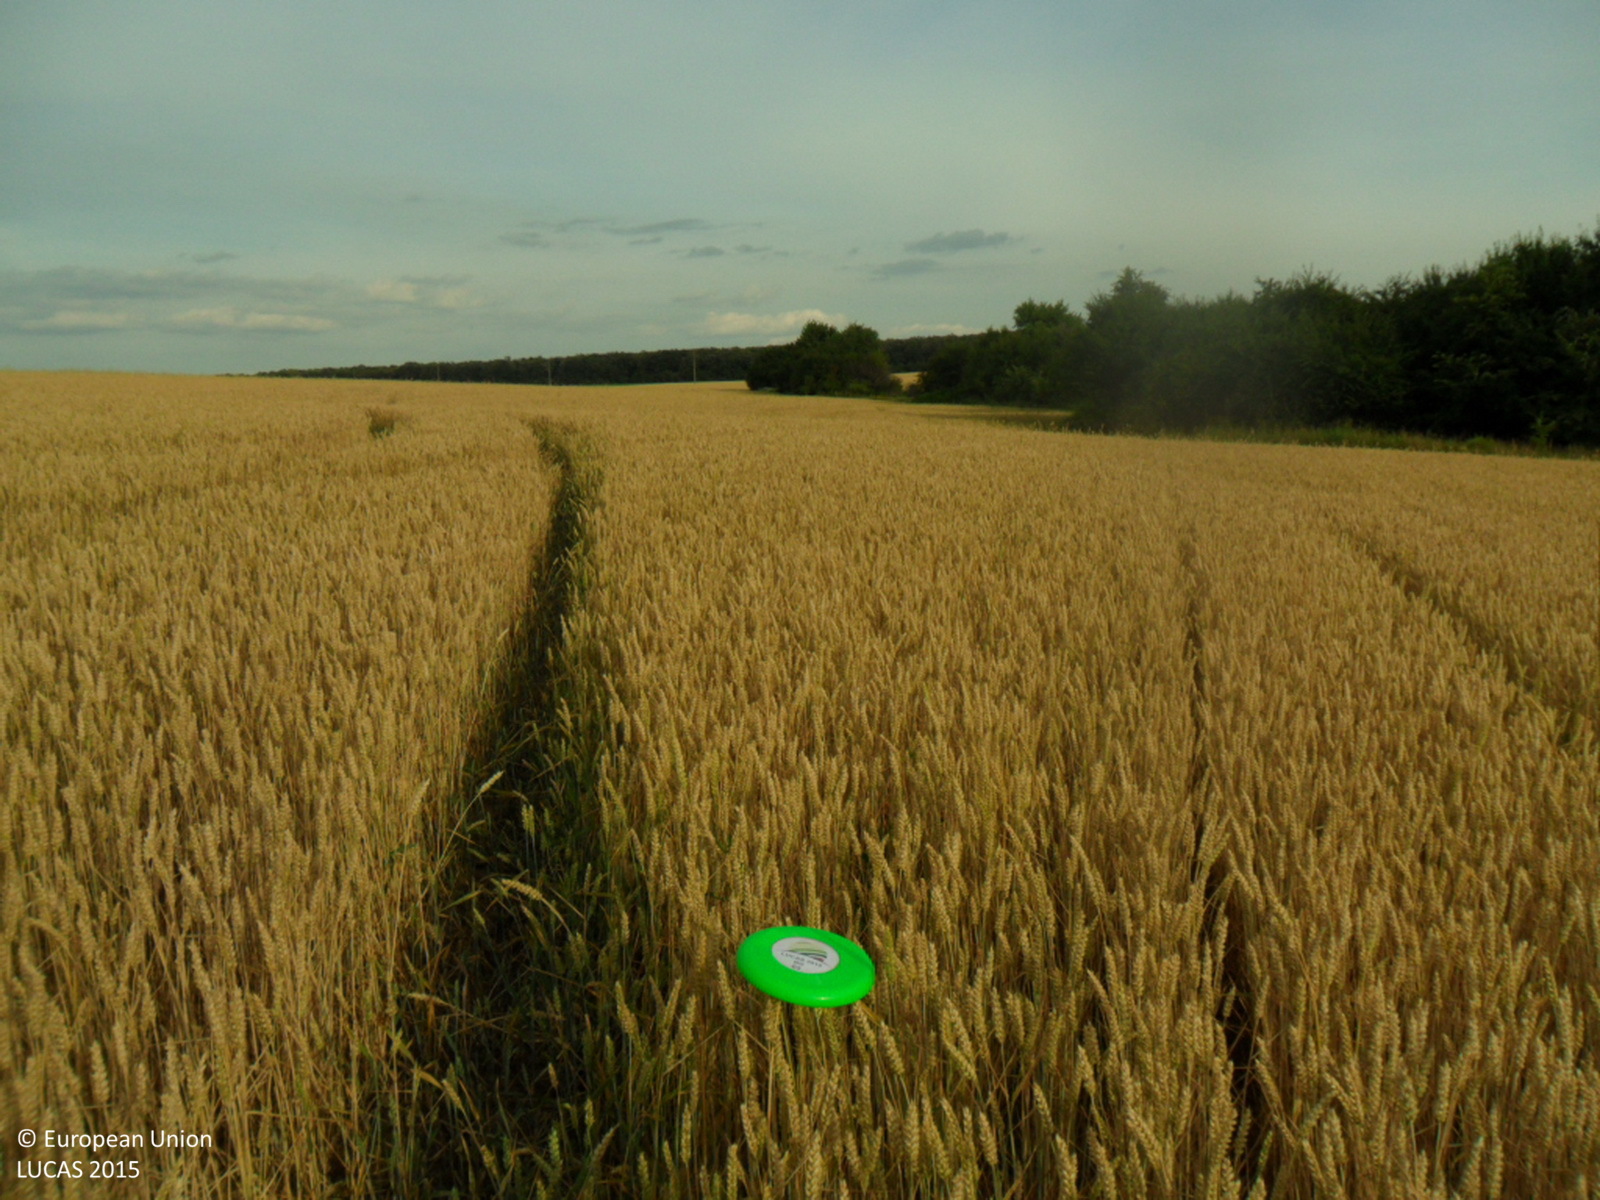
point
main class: Cropland
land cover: Common wheat
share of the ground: > 75 %
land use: Agriculture (excluding fallow land and kitchen gardens)
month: June
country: BG
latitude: 43.5795
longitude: 26.6668
